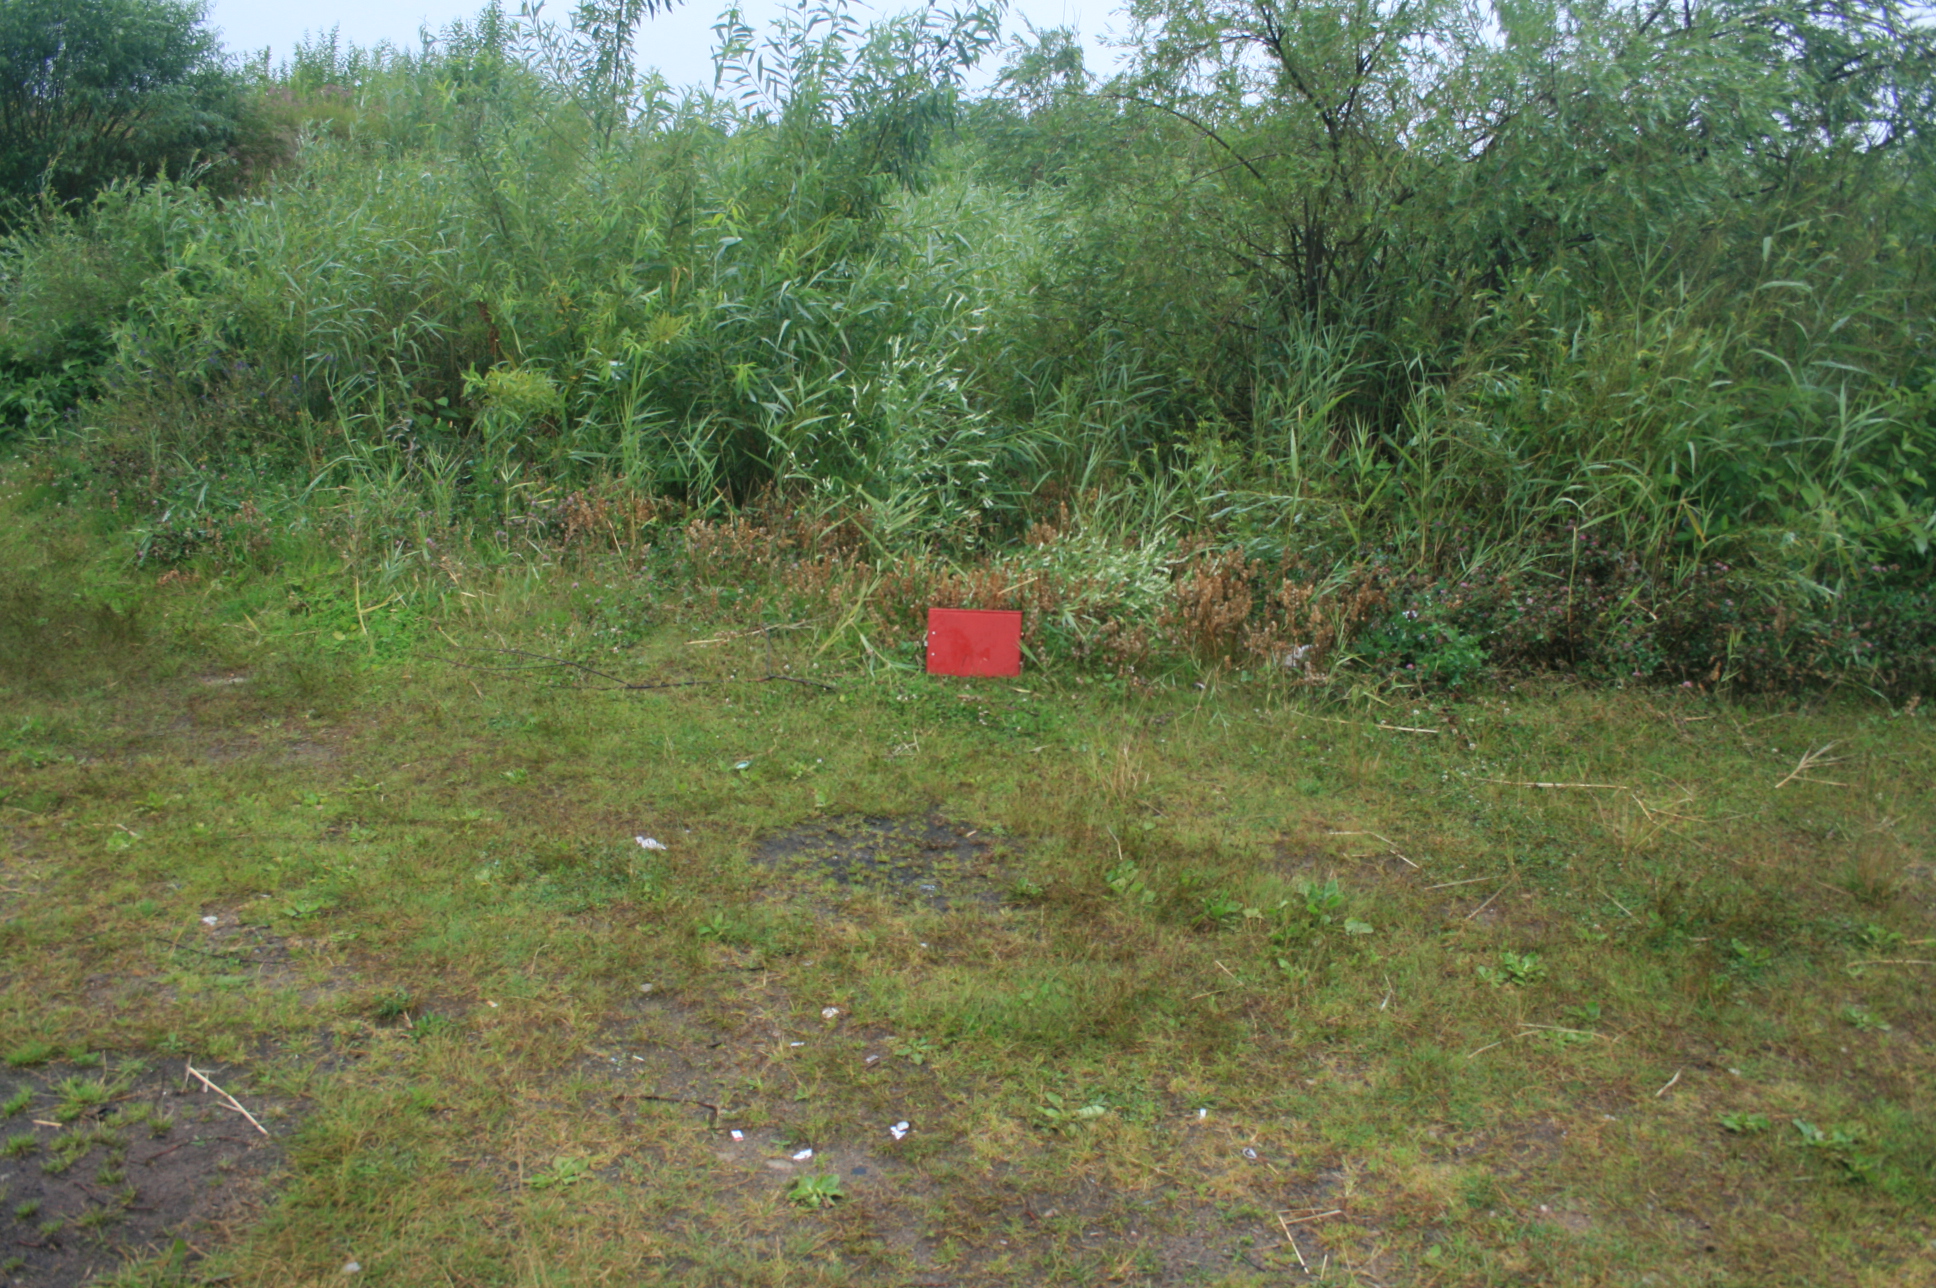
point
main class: Grassland
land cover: Grassland without tree/shrub cover
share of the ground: > 75 %
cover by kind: herbaceous plants 90 %, unconsolidated bare surface 10 %
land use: Amenities, museums, leisure
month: July
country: LT
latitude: 55.6431
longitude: 21.1788
